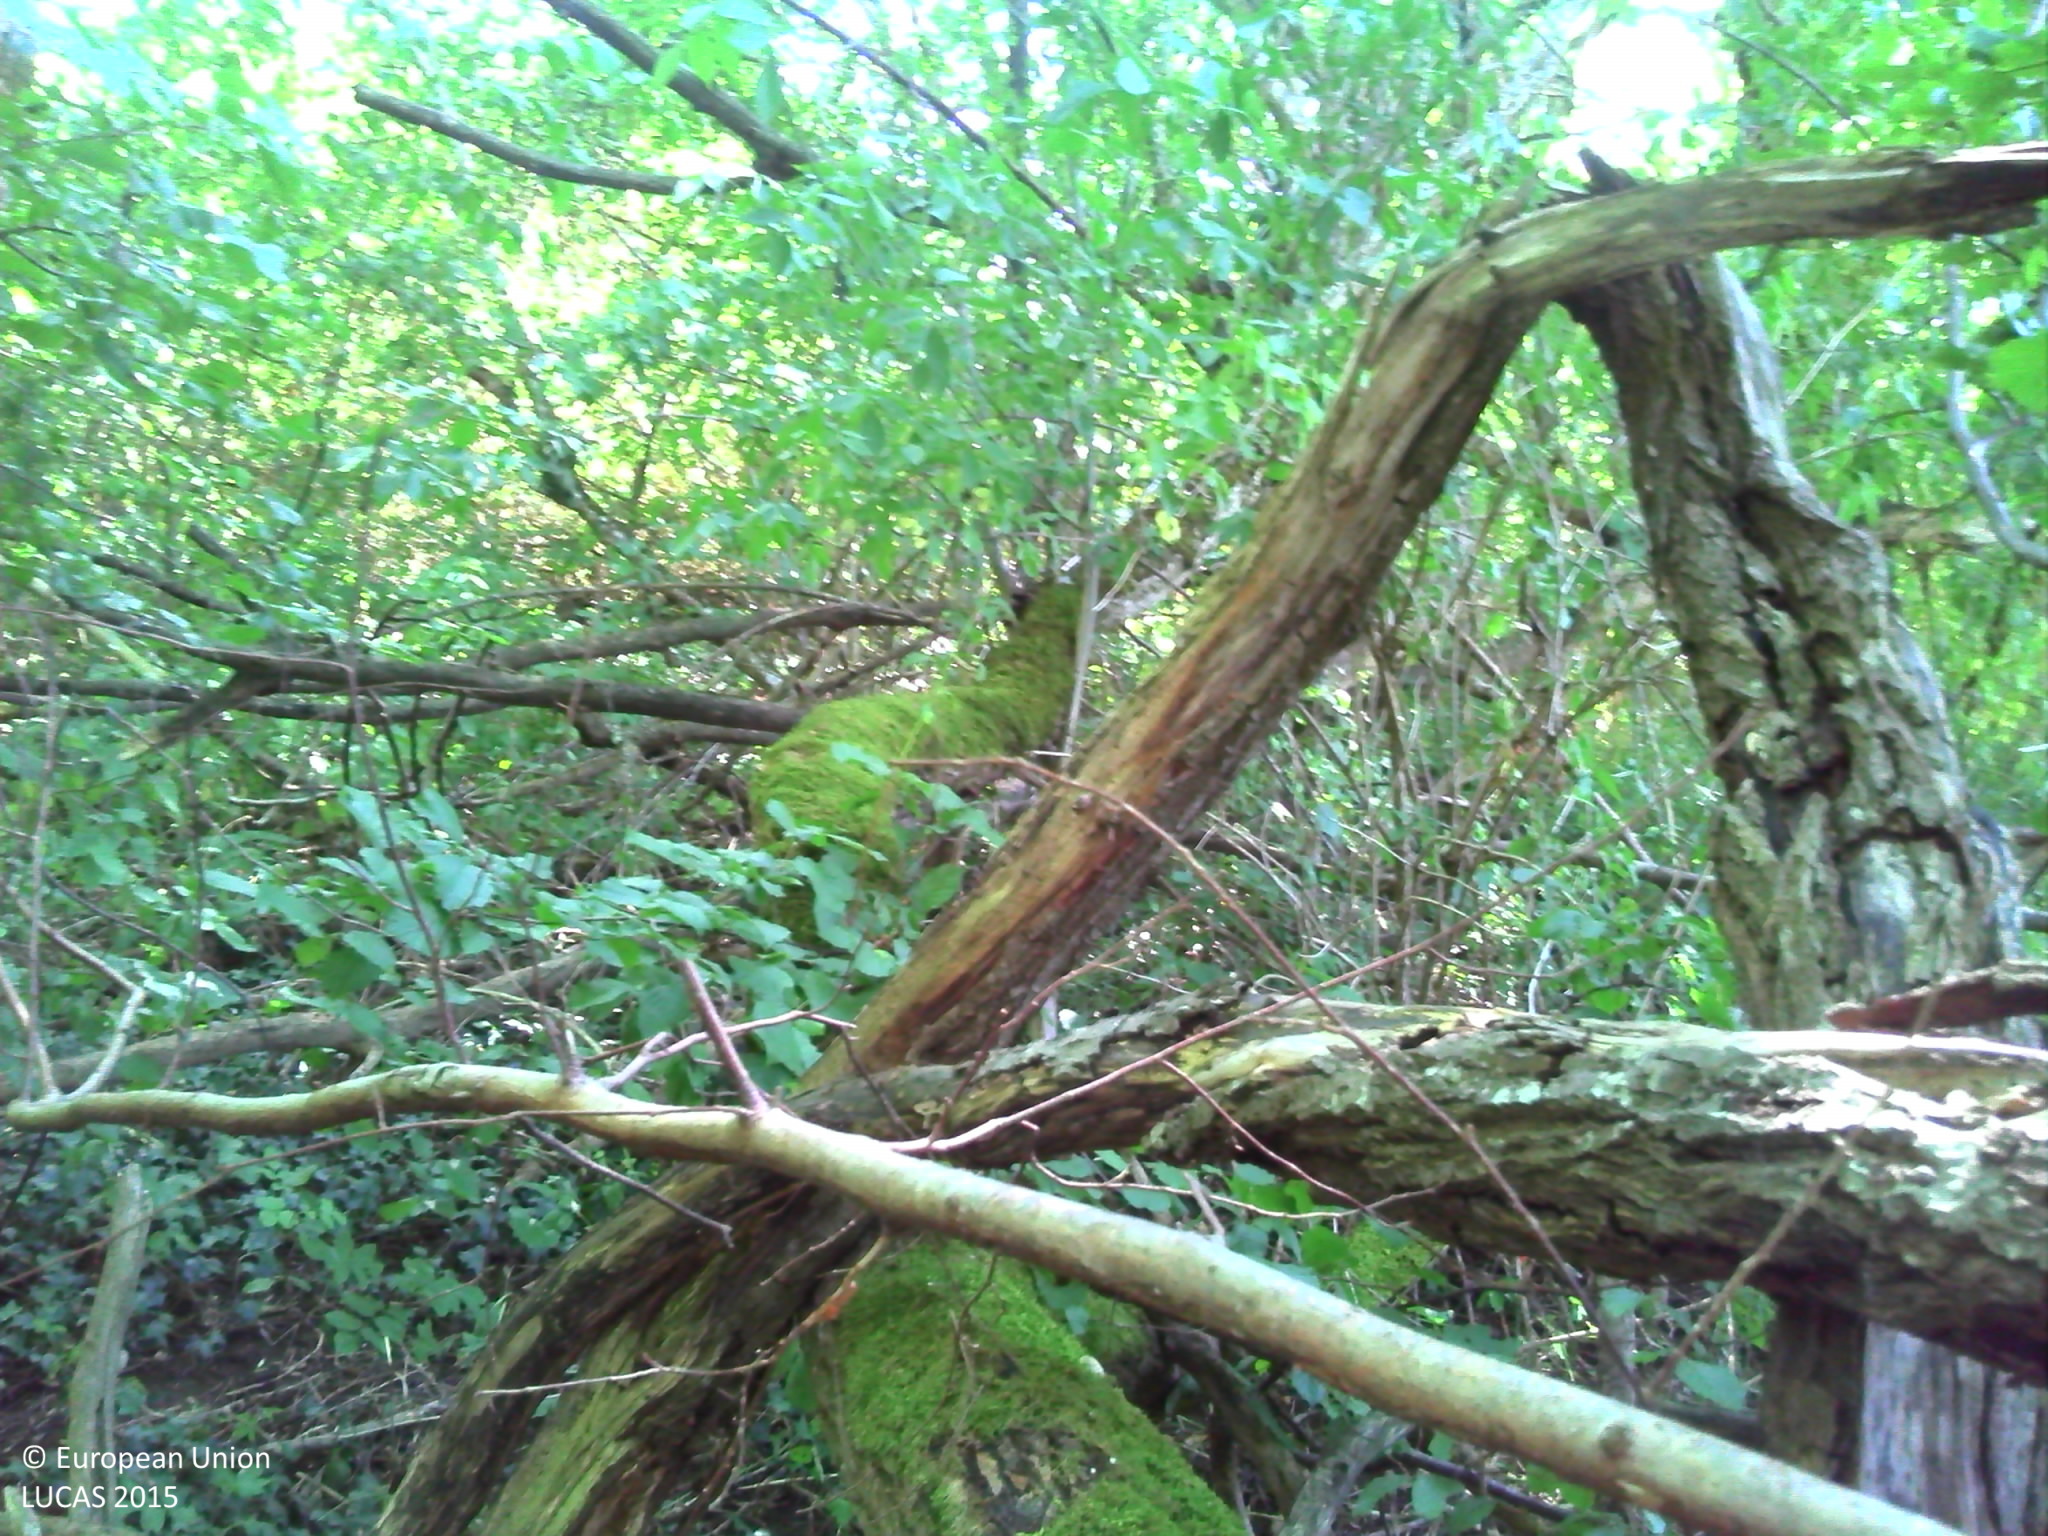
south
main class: Woodland
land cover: Broadleaved woodland
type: mesophytic deciduous forest
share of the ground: > 75 %
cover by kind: broadleaved forest trees 50 %, herbaceous plants 30 %, unconsolidated bare surface 20 %
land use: Agriculture (excluding fallow land and kitchen gardens)
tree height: > 5 m
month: August
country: FR
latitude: 45.6991
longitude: 2.8971
